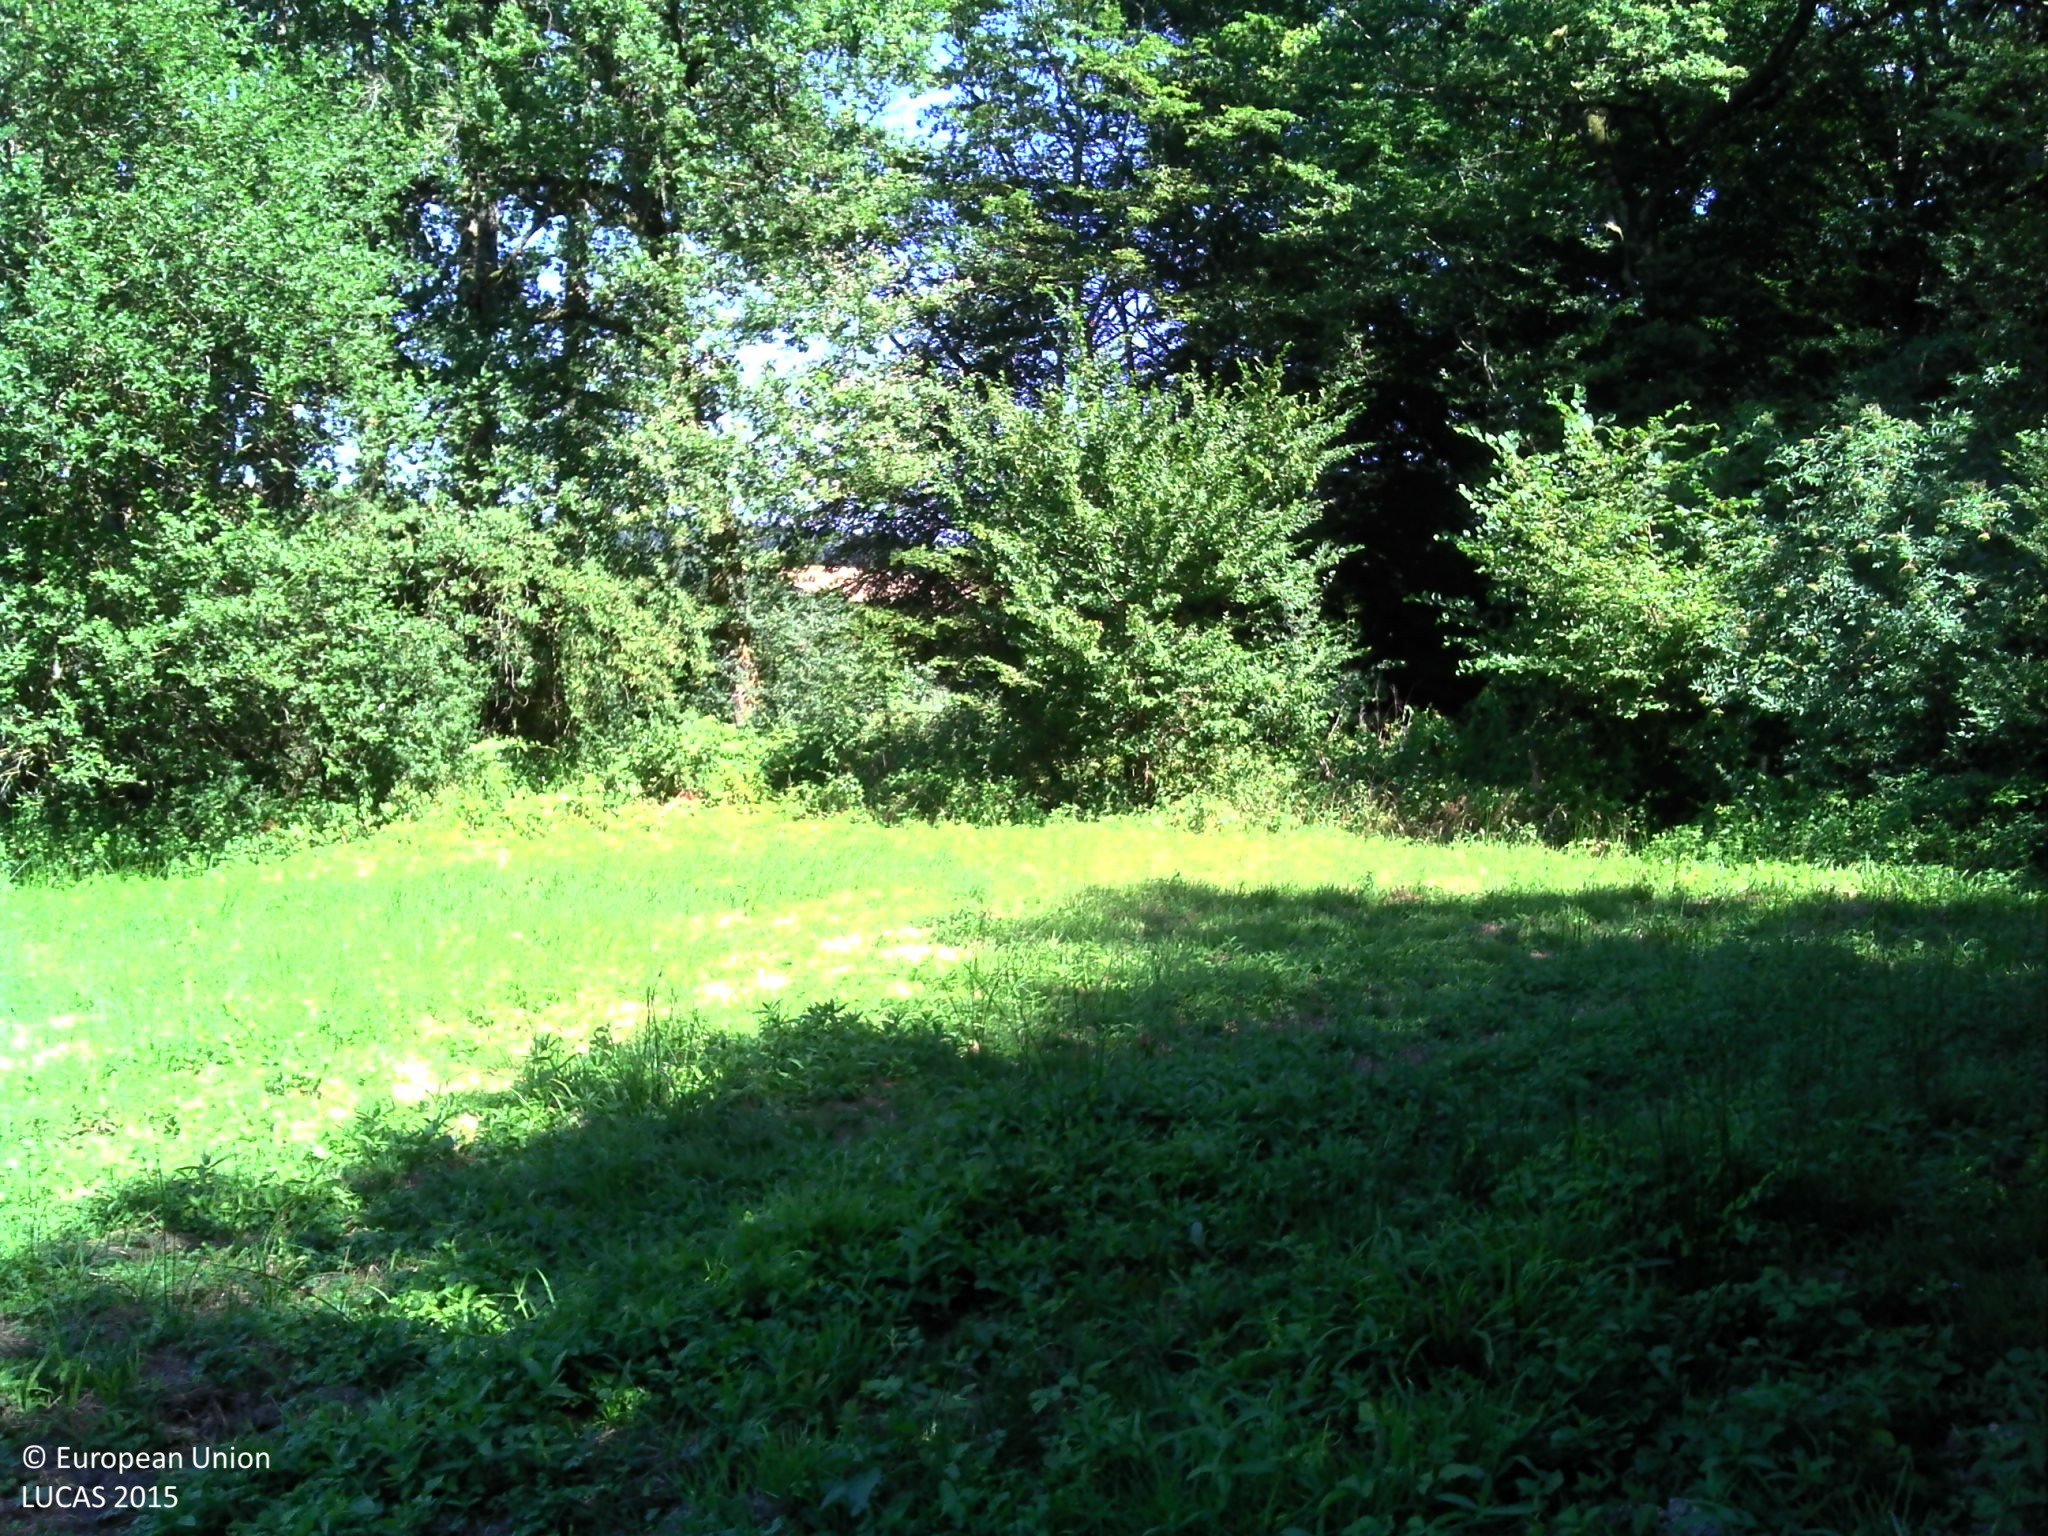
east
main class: Grassland
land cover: Grassland without tree/shrub cover
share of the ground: > 75 %
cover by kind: herbaceous plants 100 %
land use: Agriculture (excluding fallow land and kitchen gardens)
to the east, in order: Grassland without tree/shrub cover; Broadleaved woodland; Fences; Broadleaved woodland; Spontaneously vegetated surfaces; Inland fresh water bodies; Broadleaved woodland; Fences; Grassland without tree/shrub cover; Maize; Fences; Broadleaved woodland
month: July
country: FR
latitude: 46.9511
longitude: 3.5464
